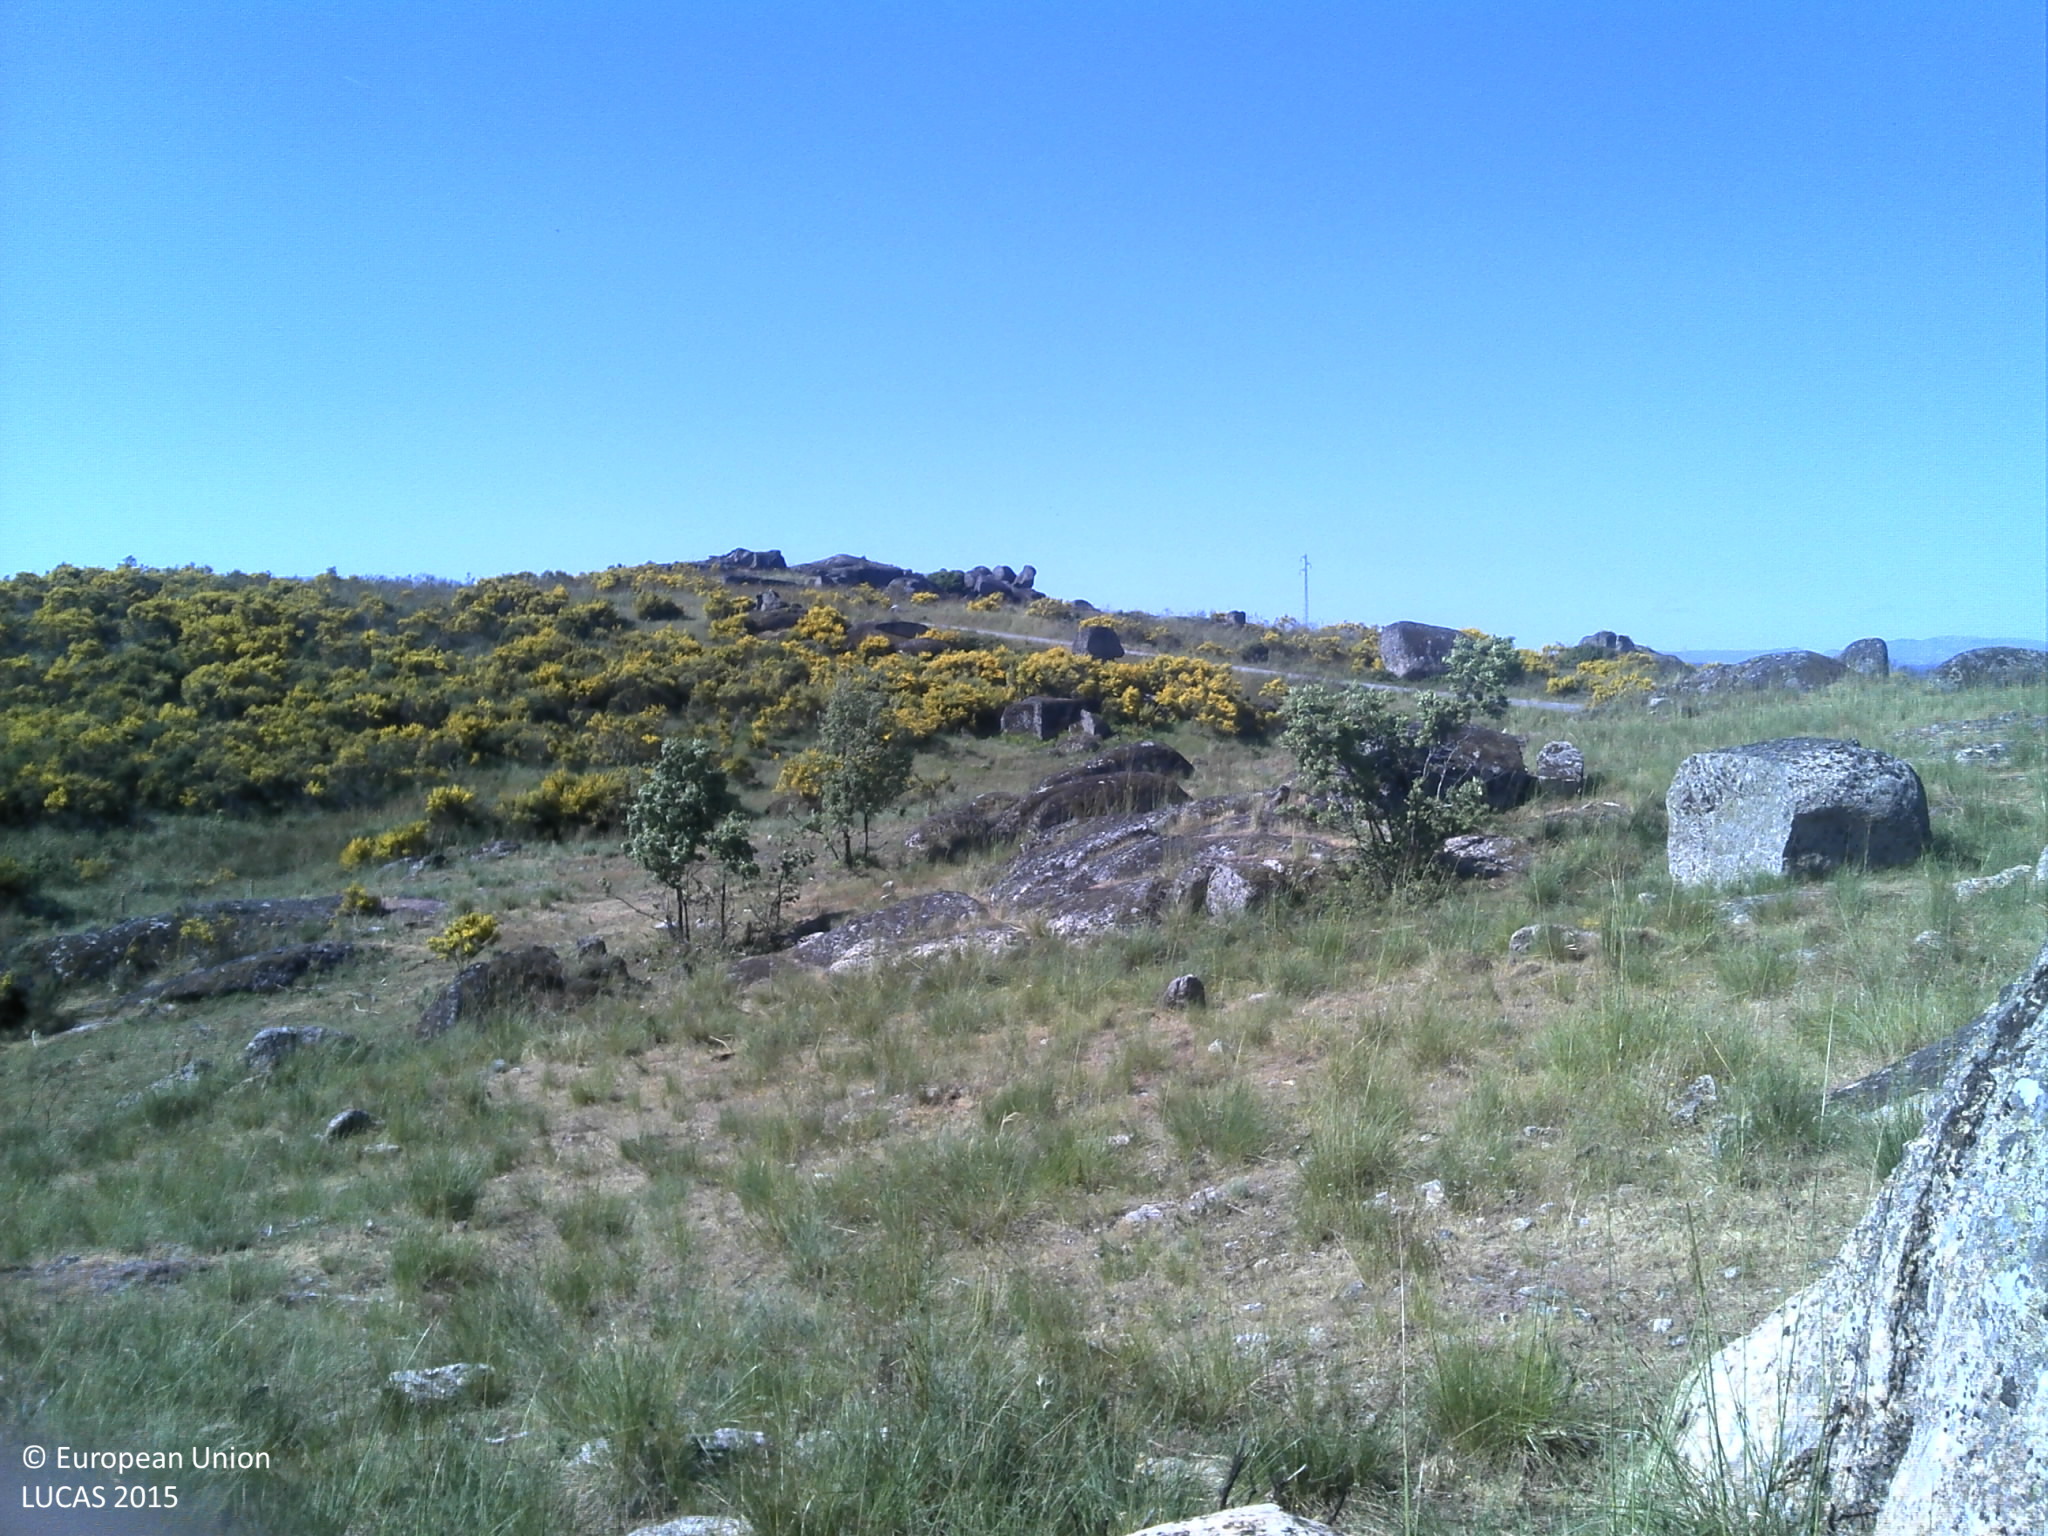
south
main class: Grassland
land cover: Grassland without tree/shrub cover
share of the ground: 10 - 25 %
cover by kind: unconsolidated bare surface 65 %, herbaceous plants 25 %, shrubs 5 %
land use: Agriculture (excluding fallow land and kitchen gardens)
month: May
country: PT
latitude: 40.5459
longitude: -7.2869
